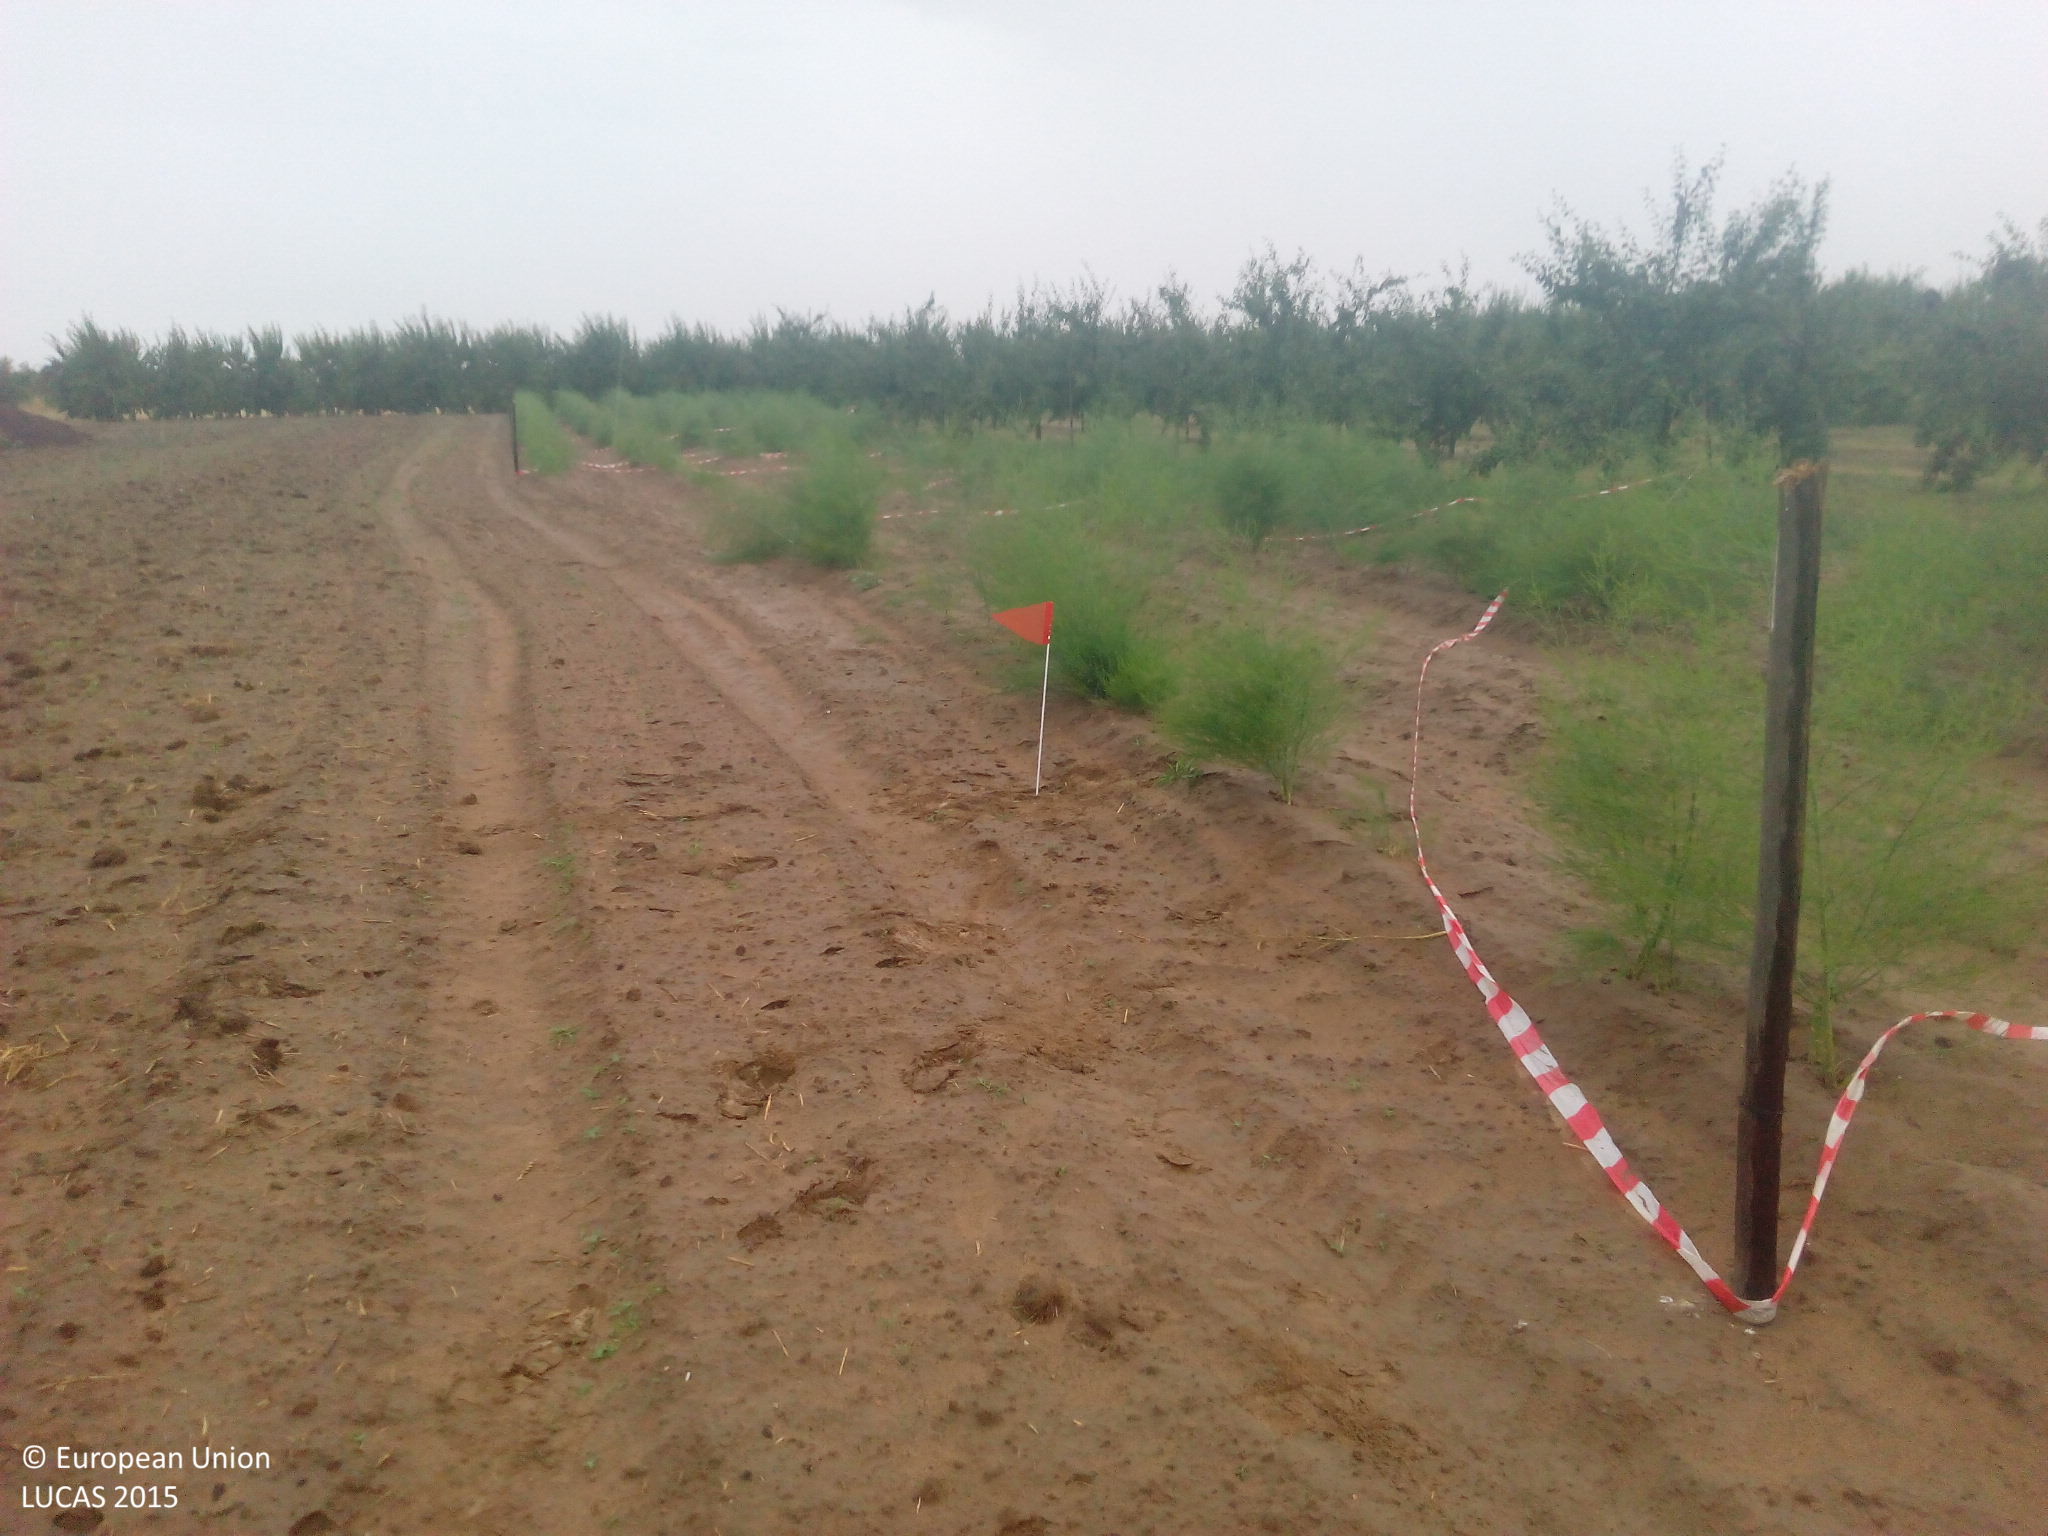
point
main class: Cropland
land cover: Common wheat
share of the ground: < 10 %
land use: Agriculture (excluding fallow land and kitchen gardens)
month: August
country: DE
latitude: 49.9893
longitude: 8.1453
